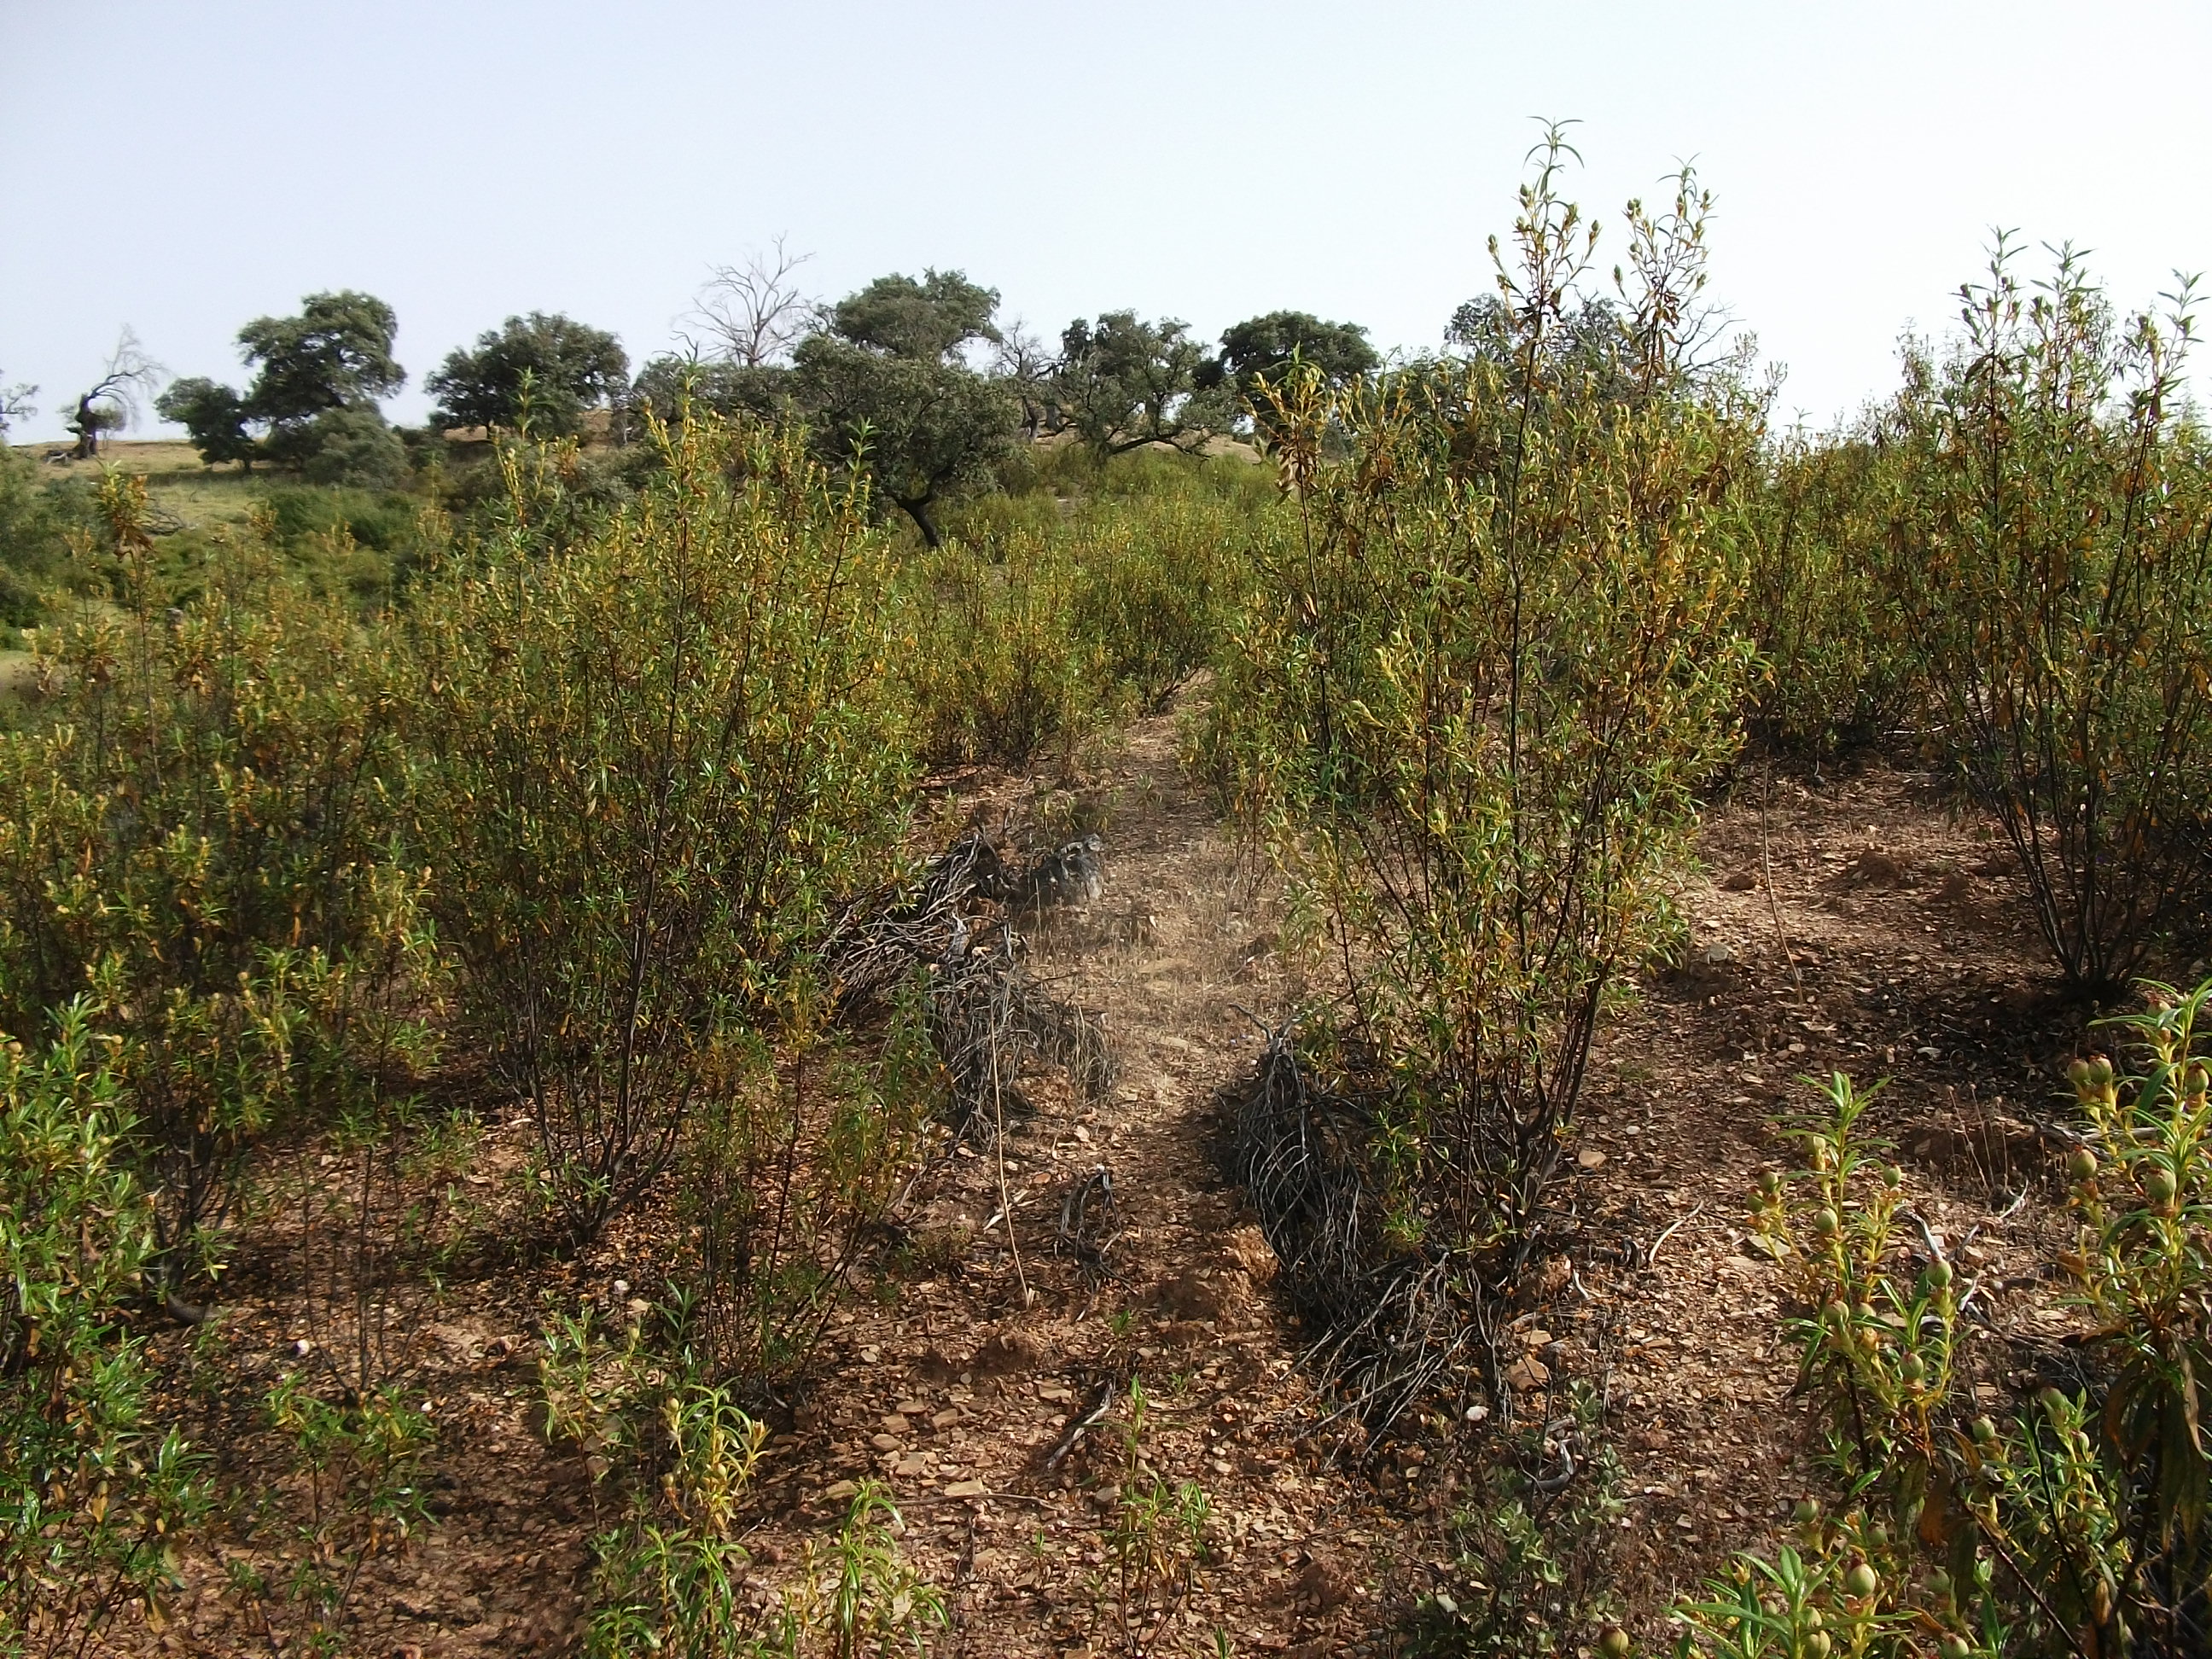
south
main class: Woodland
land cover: Broadleaved woodland
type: broadleaved evergreen forest
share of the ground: 10 - 25 %
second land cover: Spontaneously vegetated surfaces
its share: > 75 %
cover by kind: shrubs 90 %, broadleaved forest trees 10 %
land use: Agriculture (excluding fallow land and kitchen gardens)
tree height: > 5 m
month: May
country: ES
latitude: 37.6826
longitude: -6.9999
